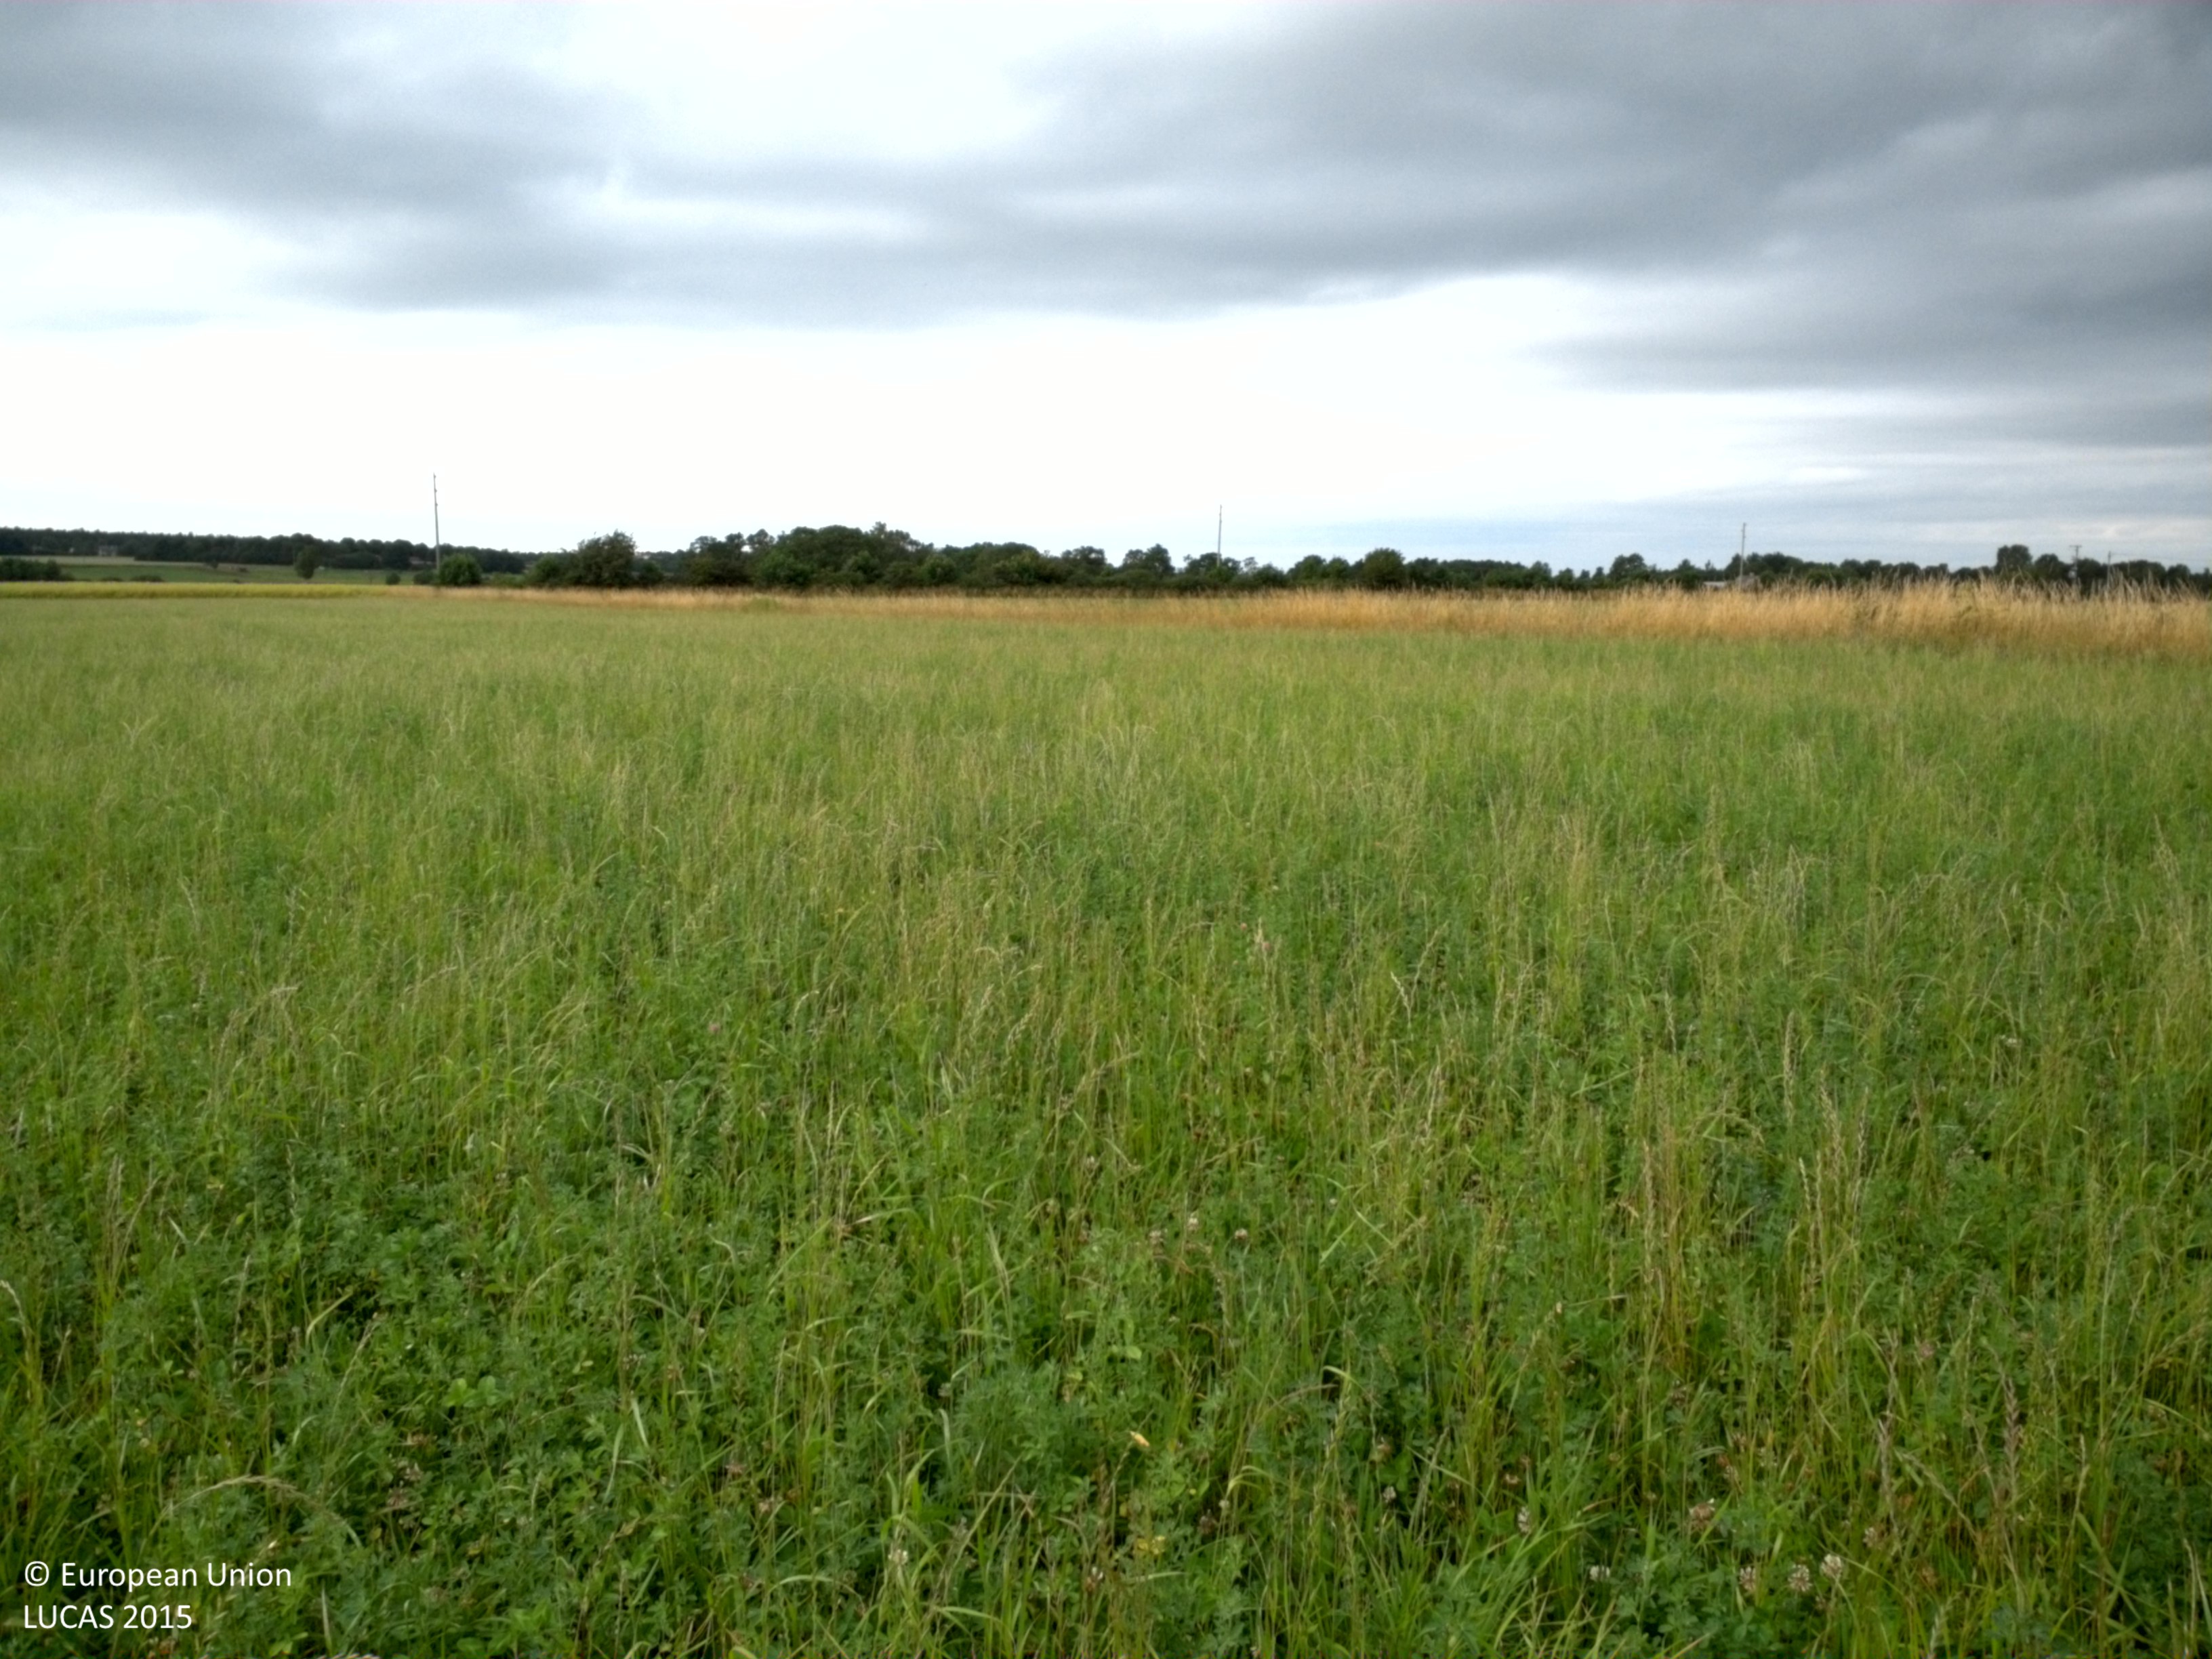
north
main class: Cropland
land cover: Temporary grasslands
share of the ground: > 75 %
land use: Agriculture (excluding fallow land and kitchen gardens)
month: July
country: SE
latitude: 57.5300
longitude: 18.2741
